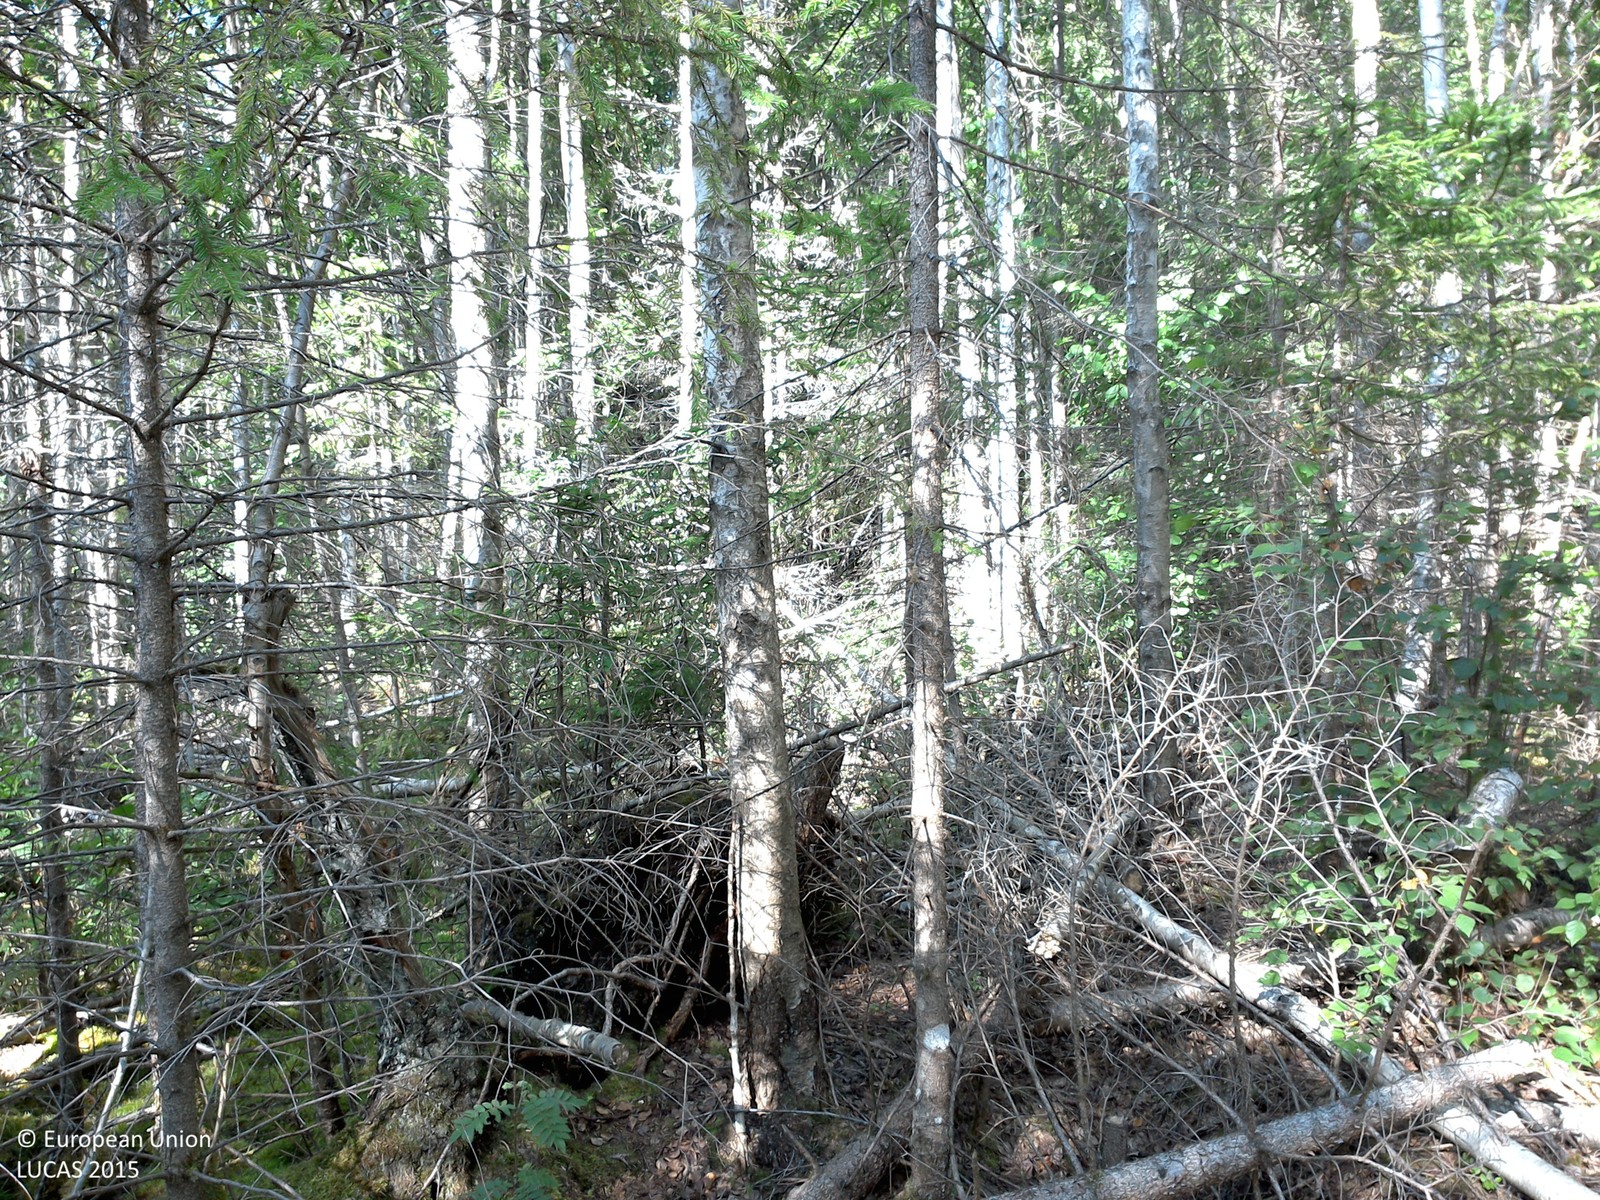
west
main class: Woodland
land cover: Broadleaved woodland
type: hemiboreal forest and nemoral coniferous forest and mixed broadleaved-coniferous forest
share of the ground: 50 - 75 %
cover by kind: broadleaved forest trees 65 %, herbaceous plants 25 %, lichens and mosses 10 %
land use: Forestry
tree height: > 5 m
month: July
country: SE
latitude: 58.2788
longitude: 15.2636
